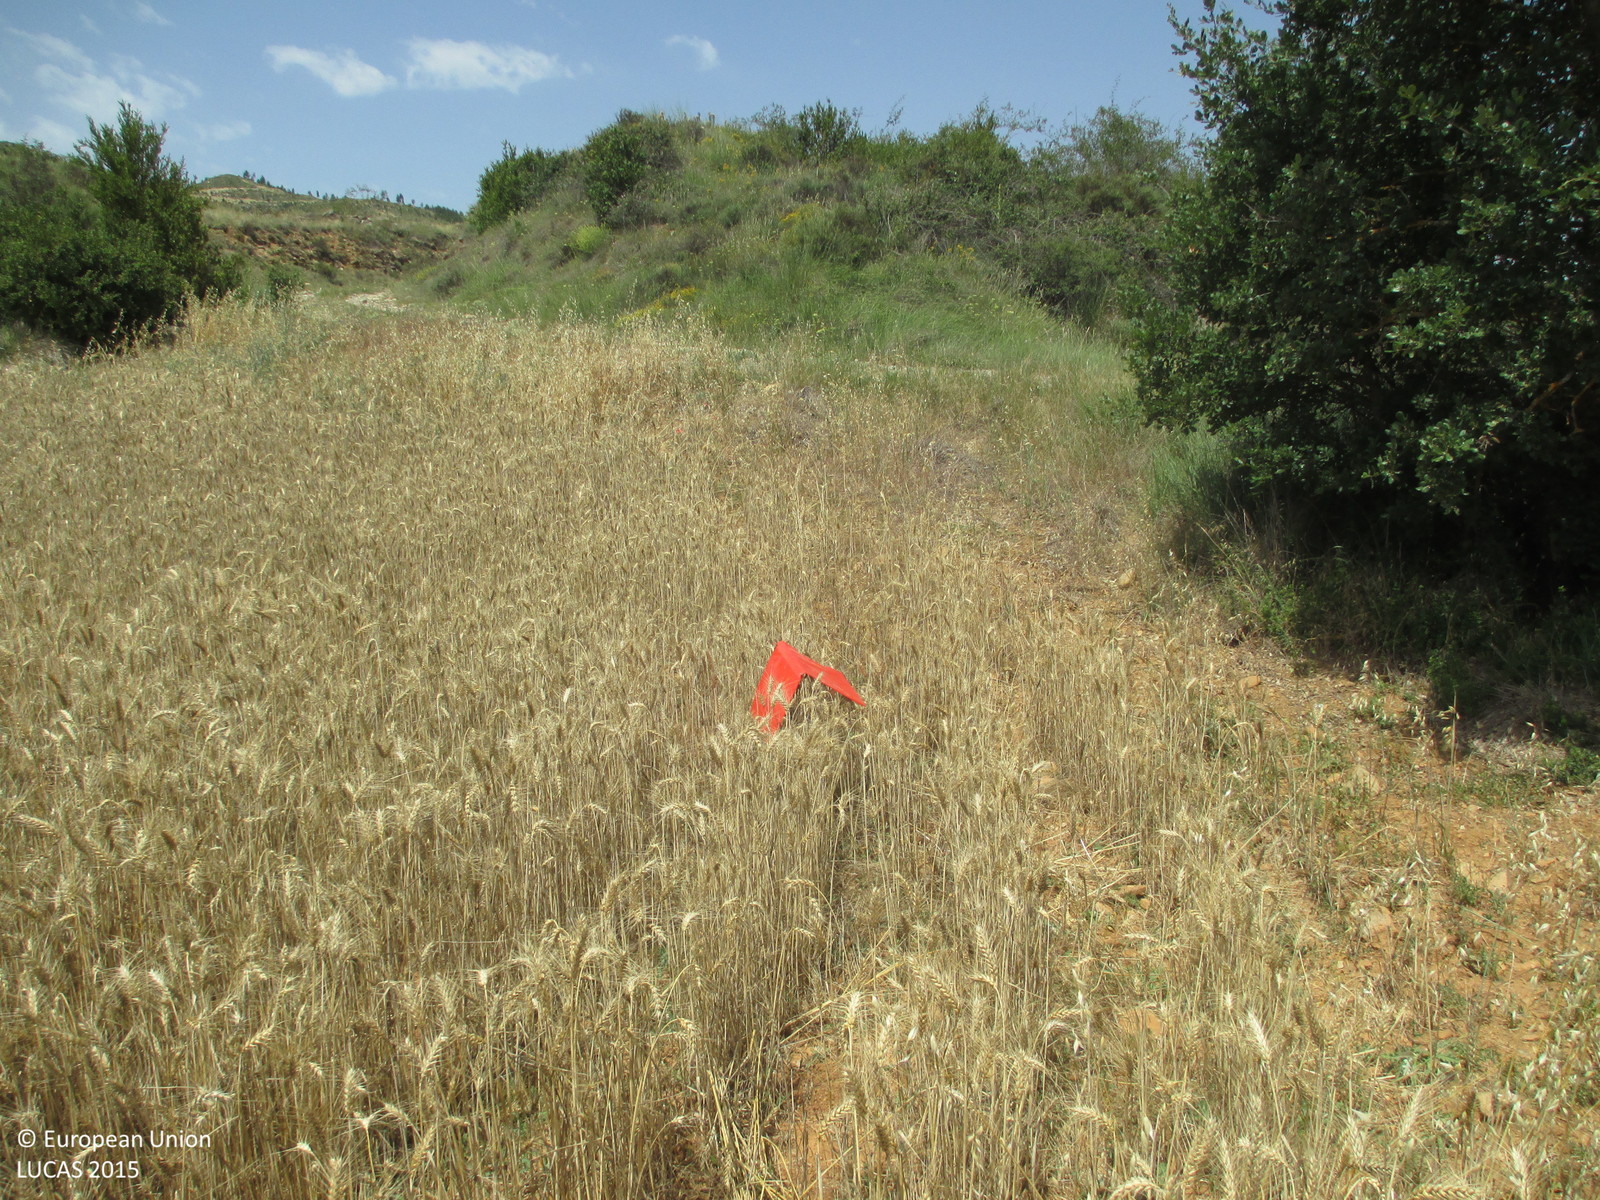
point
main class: Cropland
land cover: Common wheat
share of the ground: > 75 %
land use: Agriculture (excluding fallow land and kitchen gardens)
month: July
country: ES
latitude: 42.4198
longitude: -0.4647
